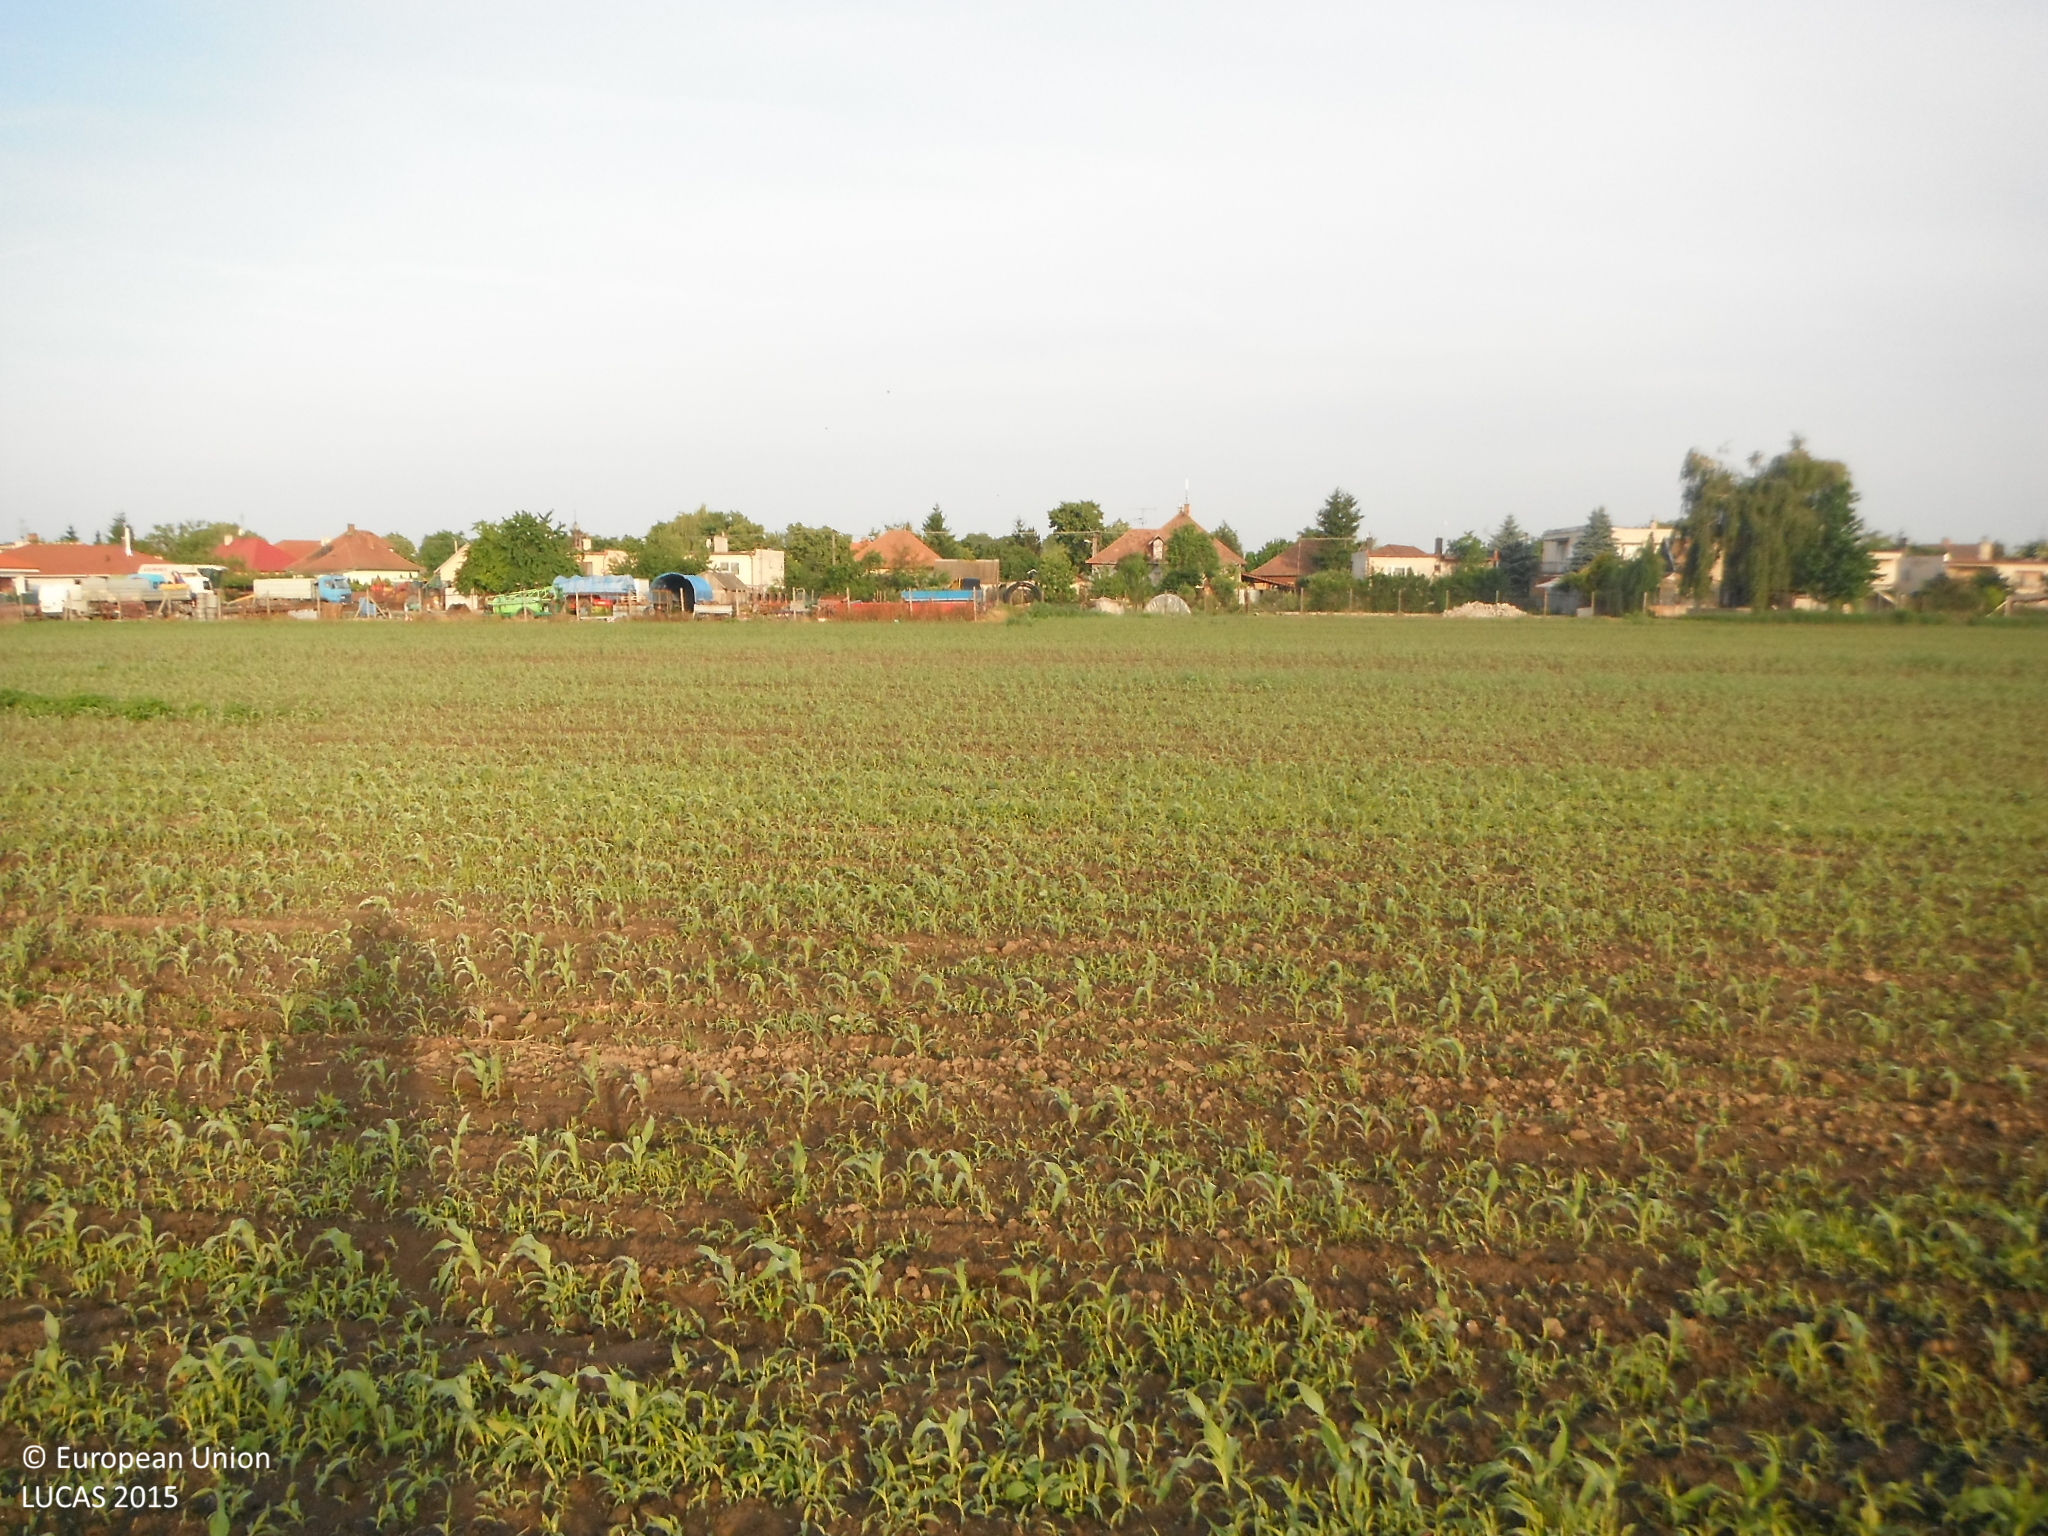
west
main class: Cropland
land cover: Maize
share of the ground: 10 - 25 %
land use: Agriculture (excluding fallow land and kitchen gardens)
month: May
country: SK
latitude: 48.1919
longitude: 17.3948
